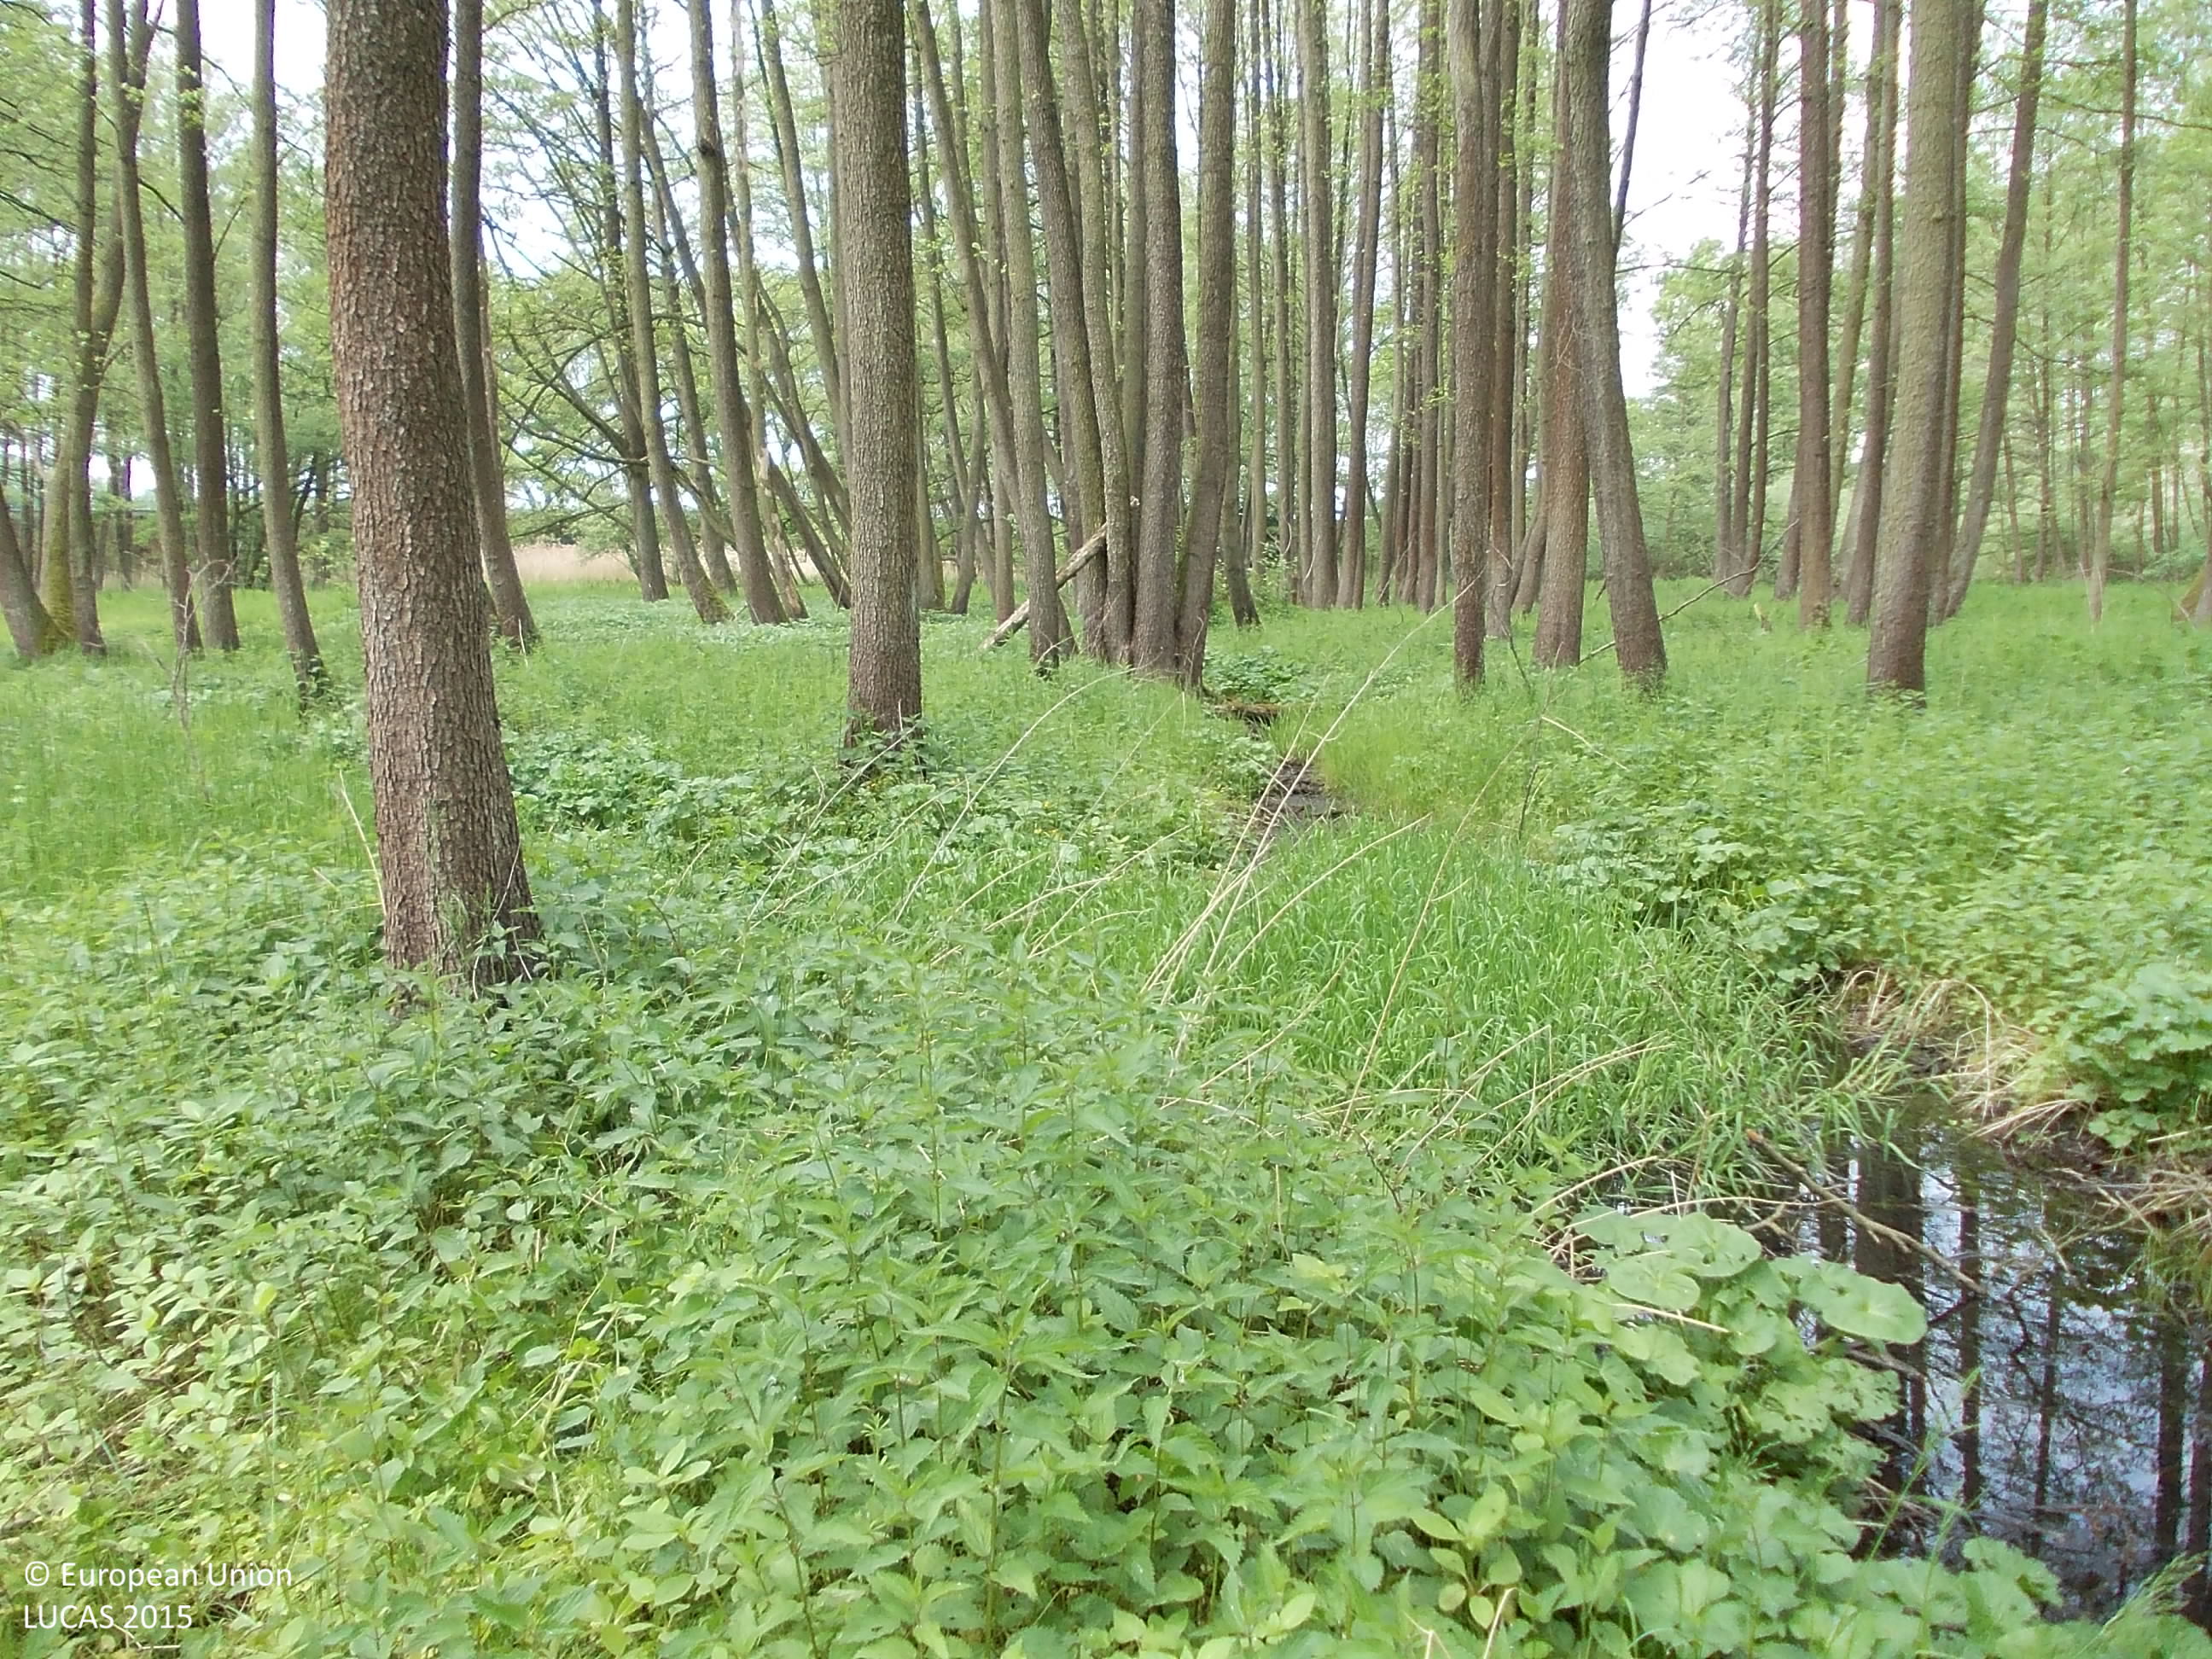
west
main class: Woodland
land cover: Broadleaved woodland
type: mire and swamp forests
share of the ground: > 75 %
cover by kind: broadleaved forest trees 80 %, herbaceous plants 20 %
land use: Semi-natural and natural areas not in use
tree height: > 5 m
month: May
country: CZ
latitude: 49.4370
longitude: 13.7927
